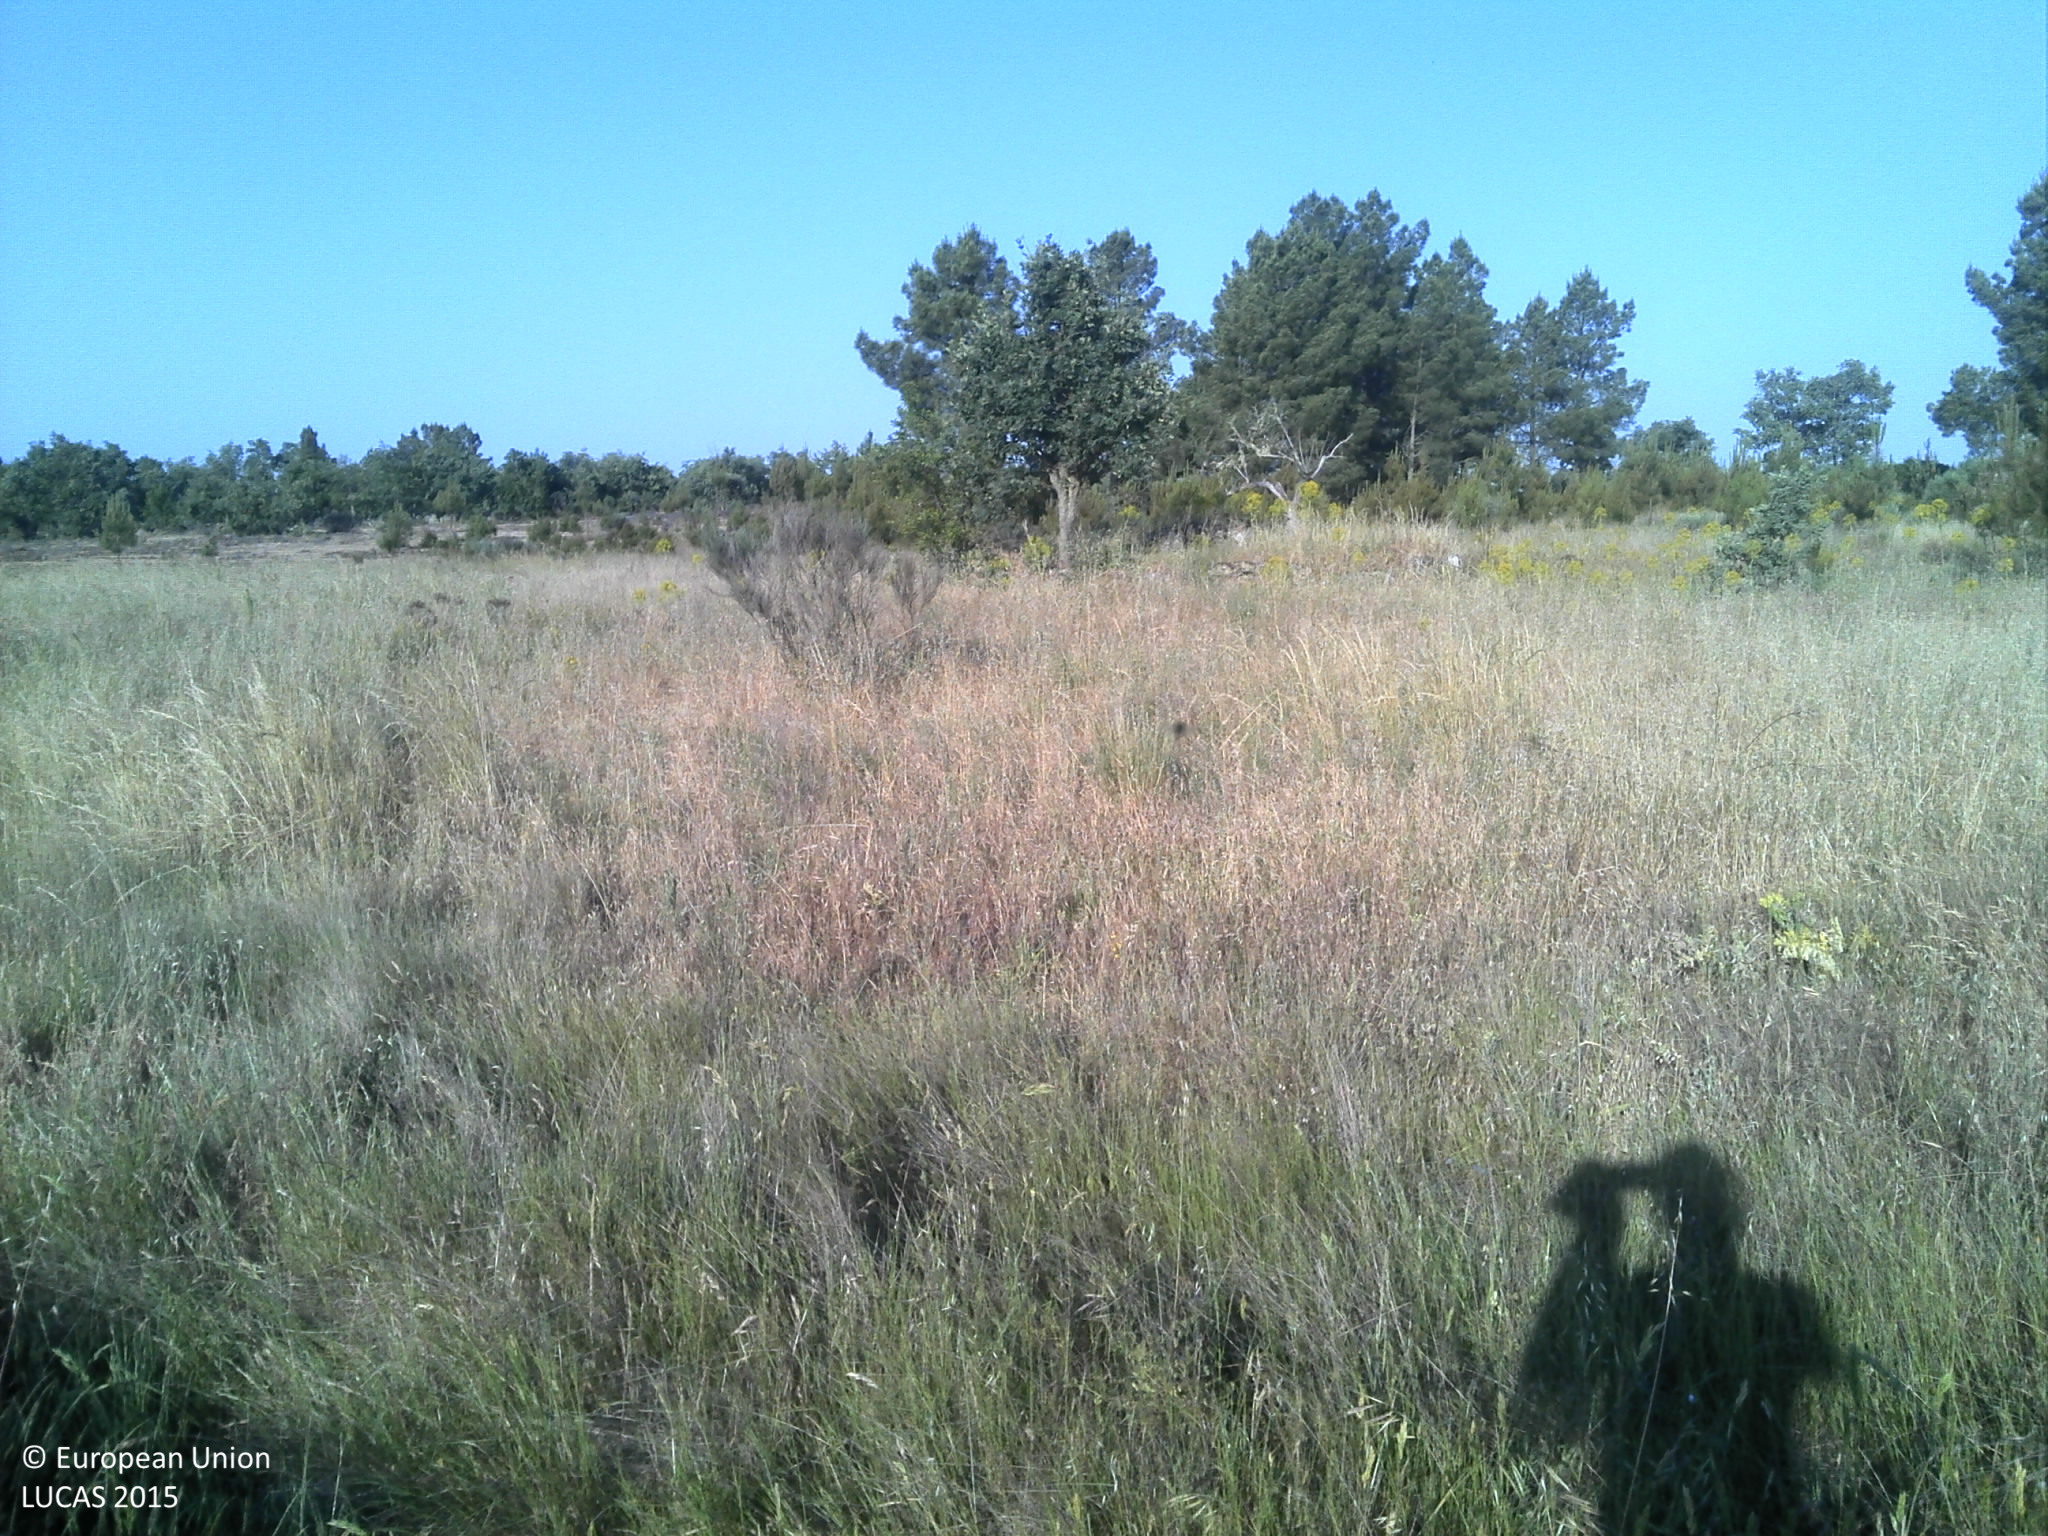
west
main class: Grassland
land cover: Grassland without tree/shrub cover
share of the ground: 50 - 75 %
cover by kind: herbaceous plants 70 %, unconsolidated bare surface 20 %
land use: Agriculture (excluding fallow land and kitchen gardens)
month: June
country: PT
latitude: 40.5637
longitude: -6.9772
